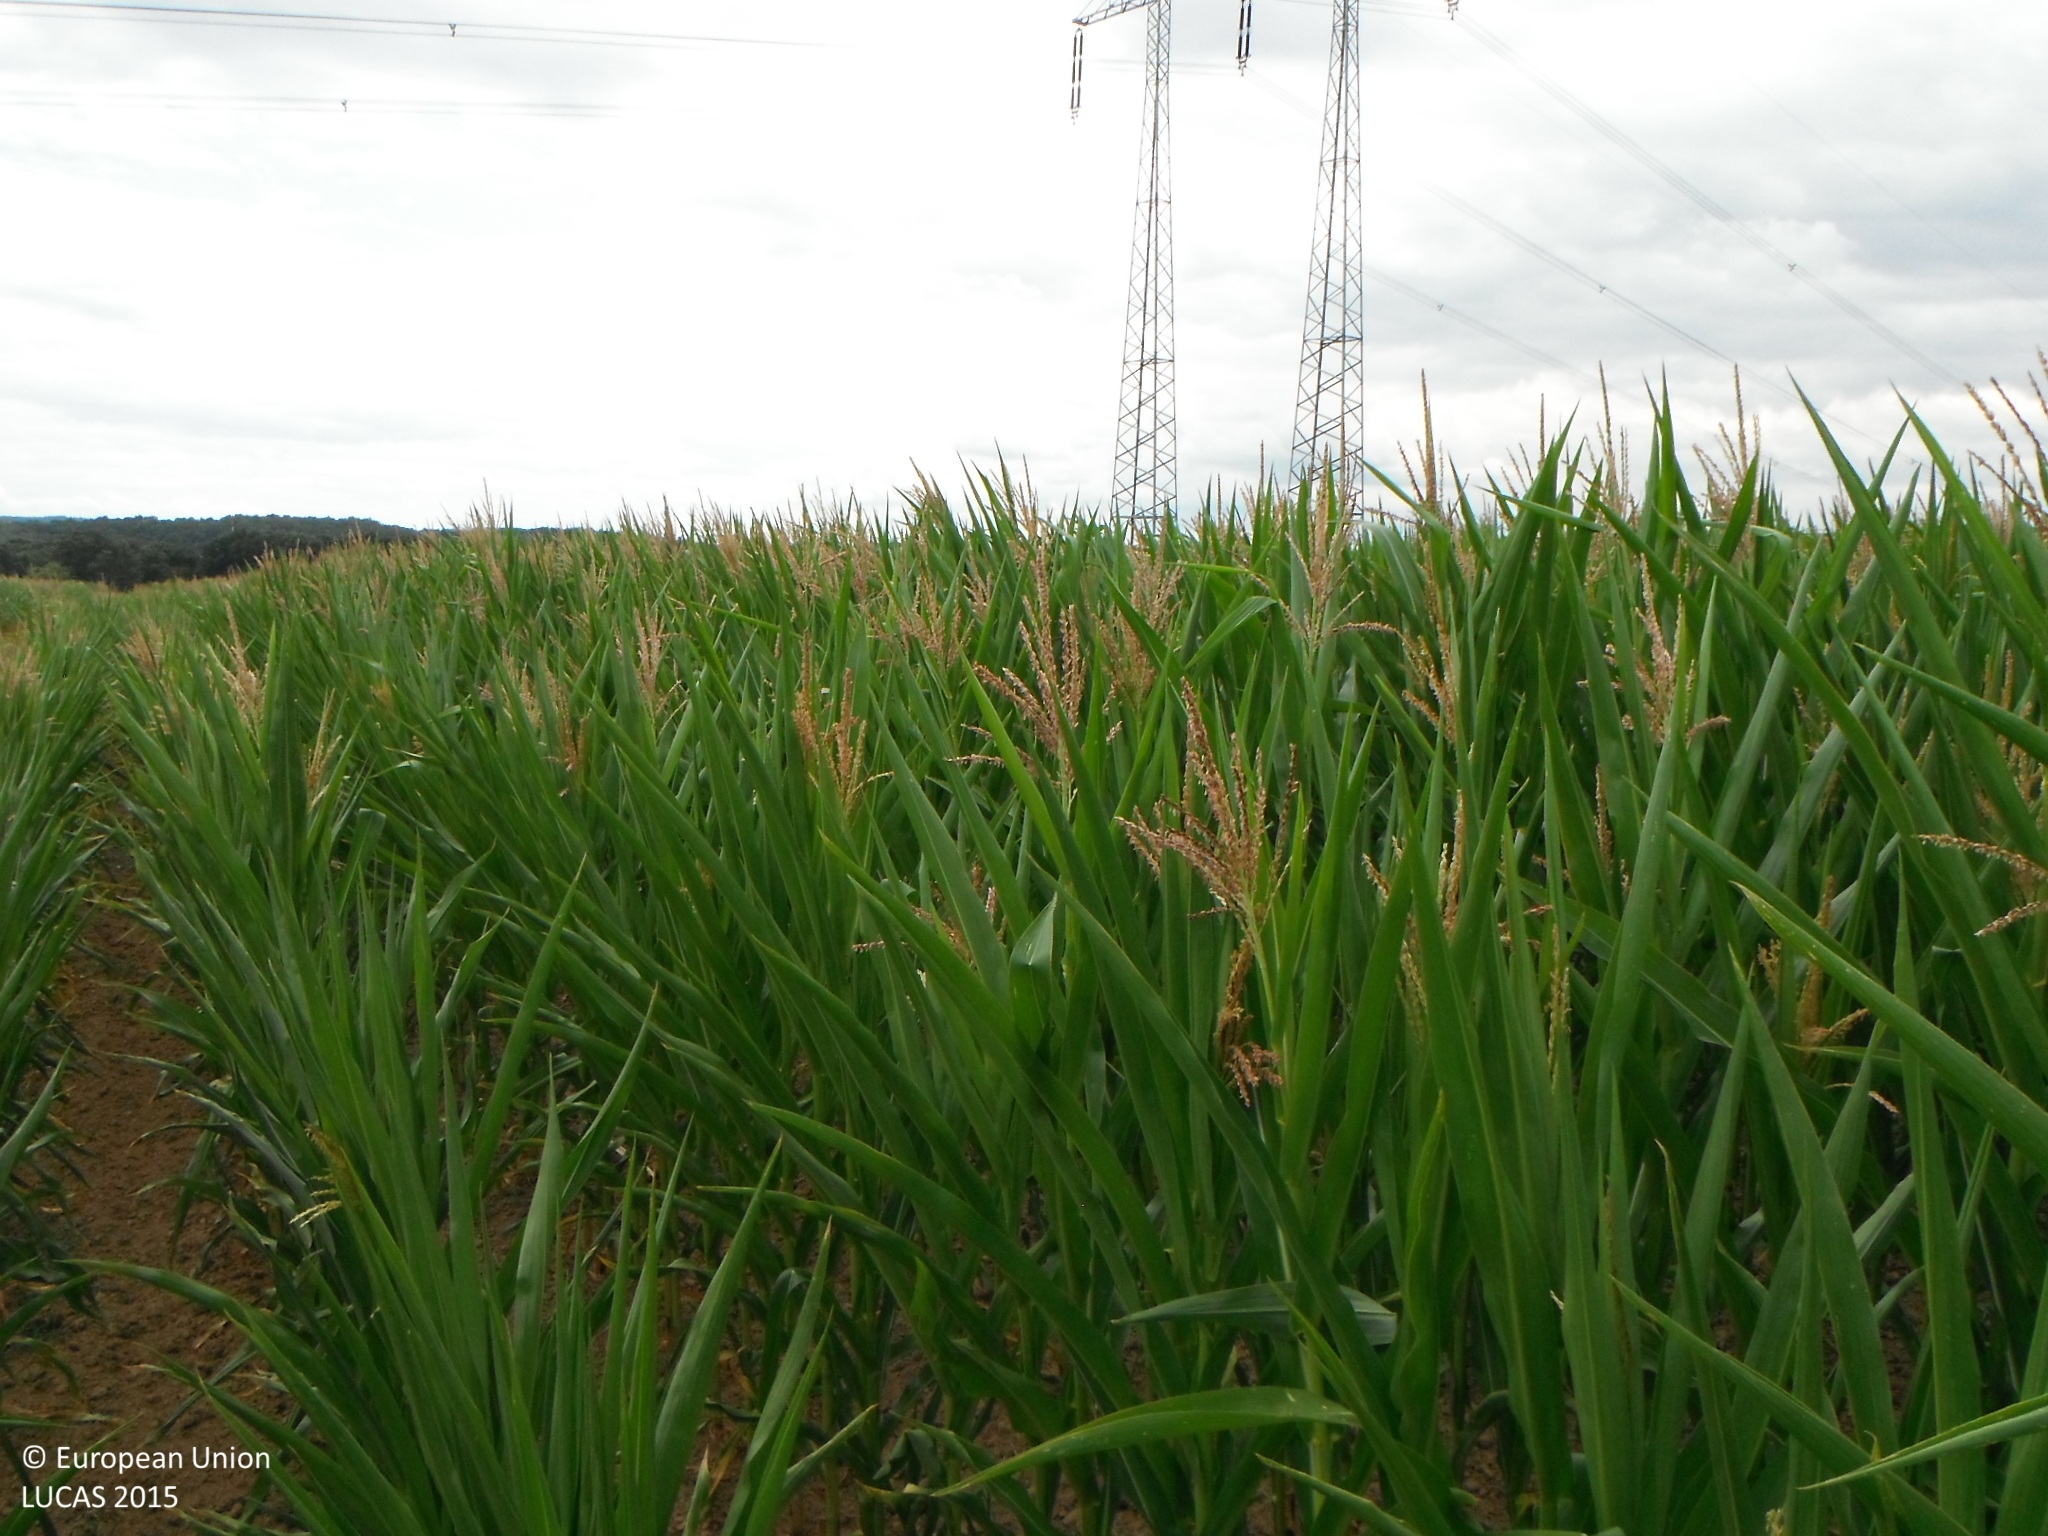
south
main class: Cropland
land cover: Maize
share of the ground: > 75 %
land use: Agriculture (excluding fallow land and kitchen gardens)
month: July
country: SK
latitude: 48.2728
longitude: 18.9798
